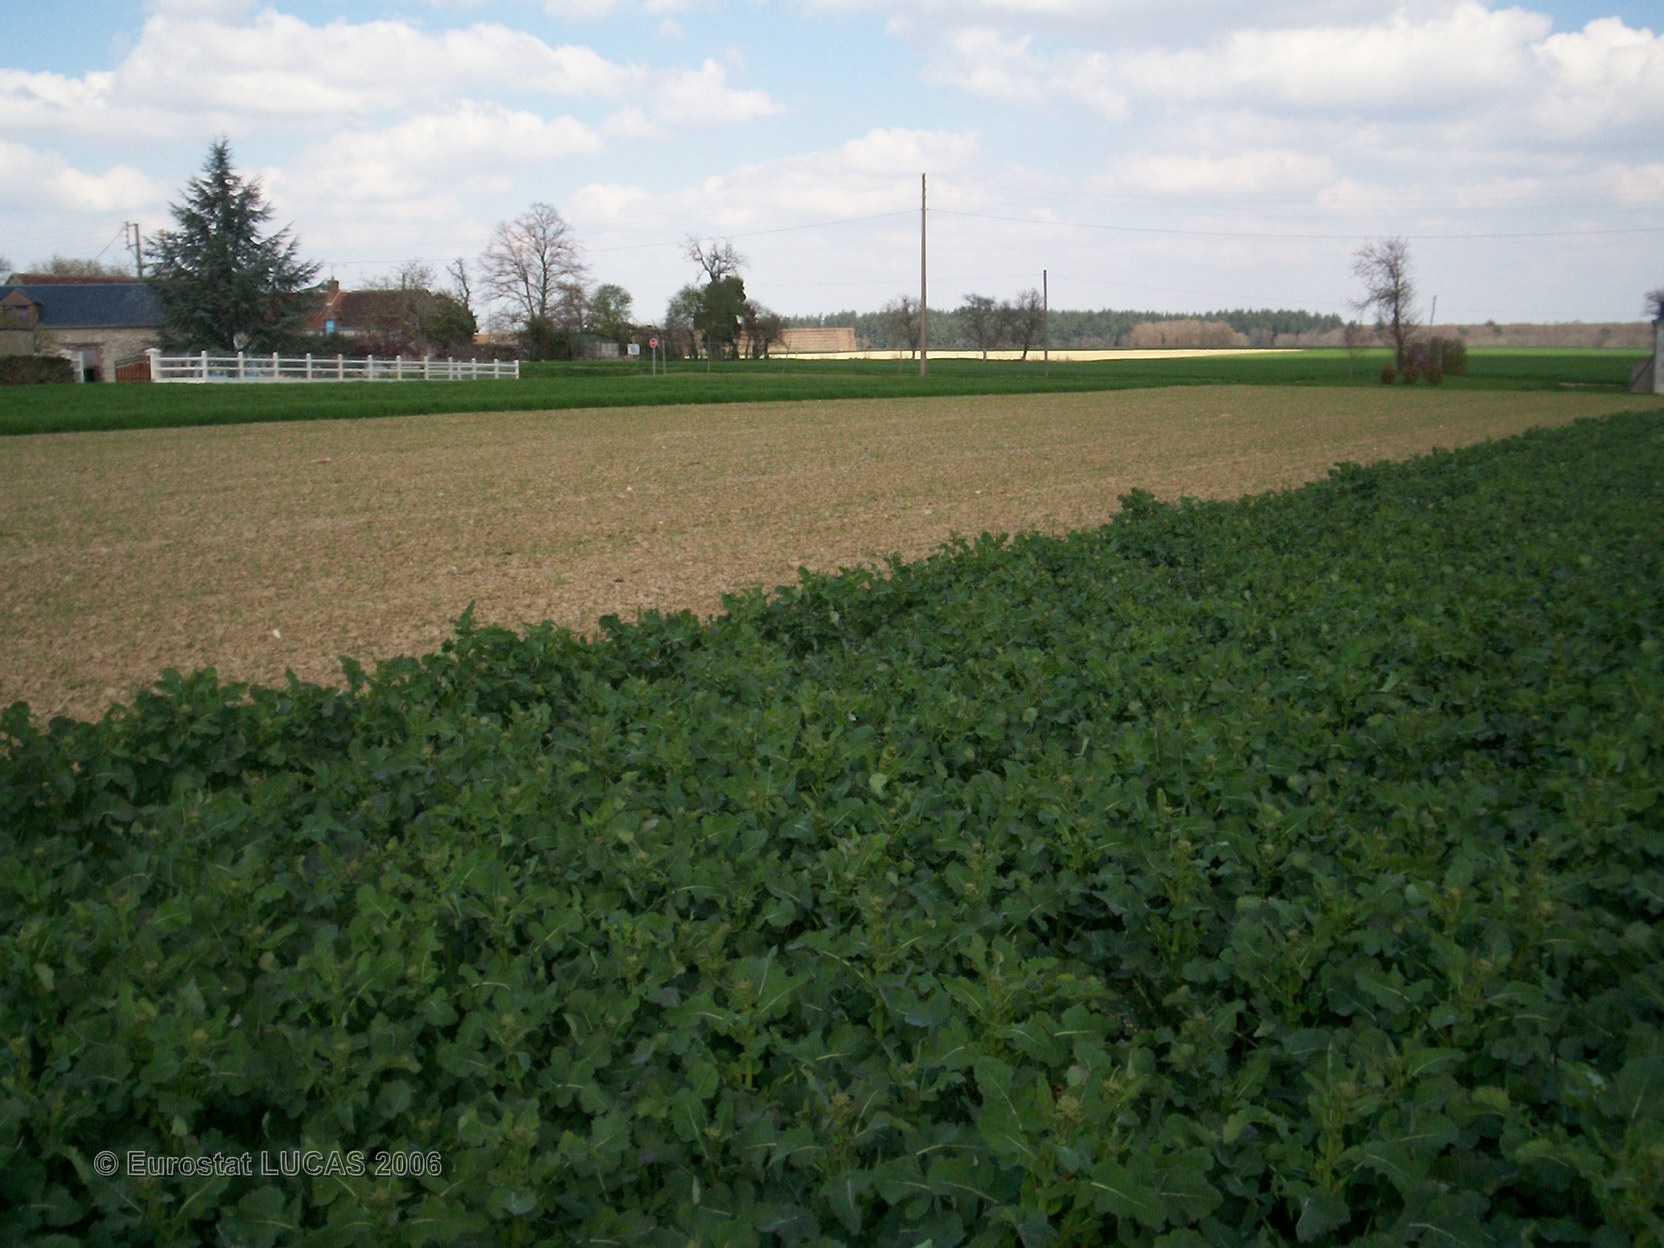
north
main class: Cropland
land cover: Rape and turnip rape
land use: Agriculture (excluding fallow land and kitchen gardens)
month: April
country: FR
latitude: 47.7975
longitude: 1.1849
